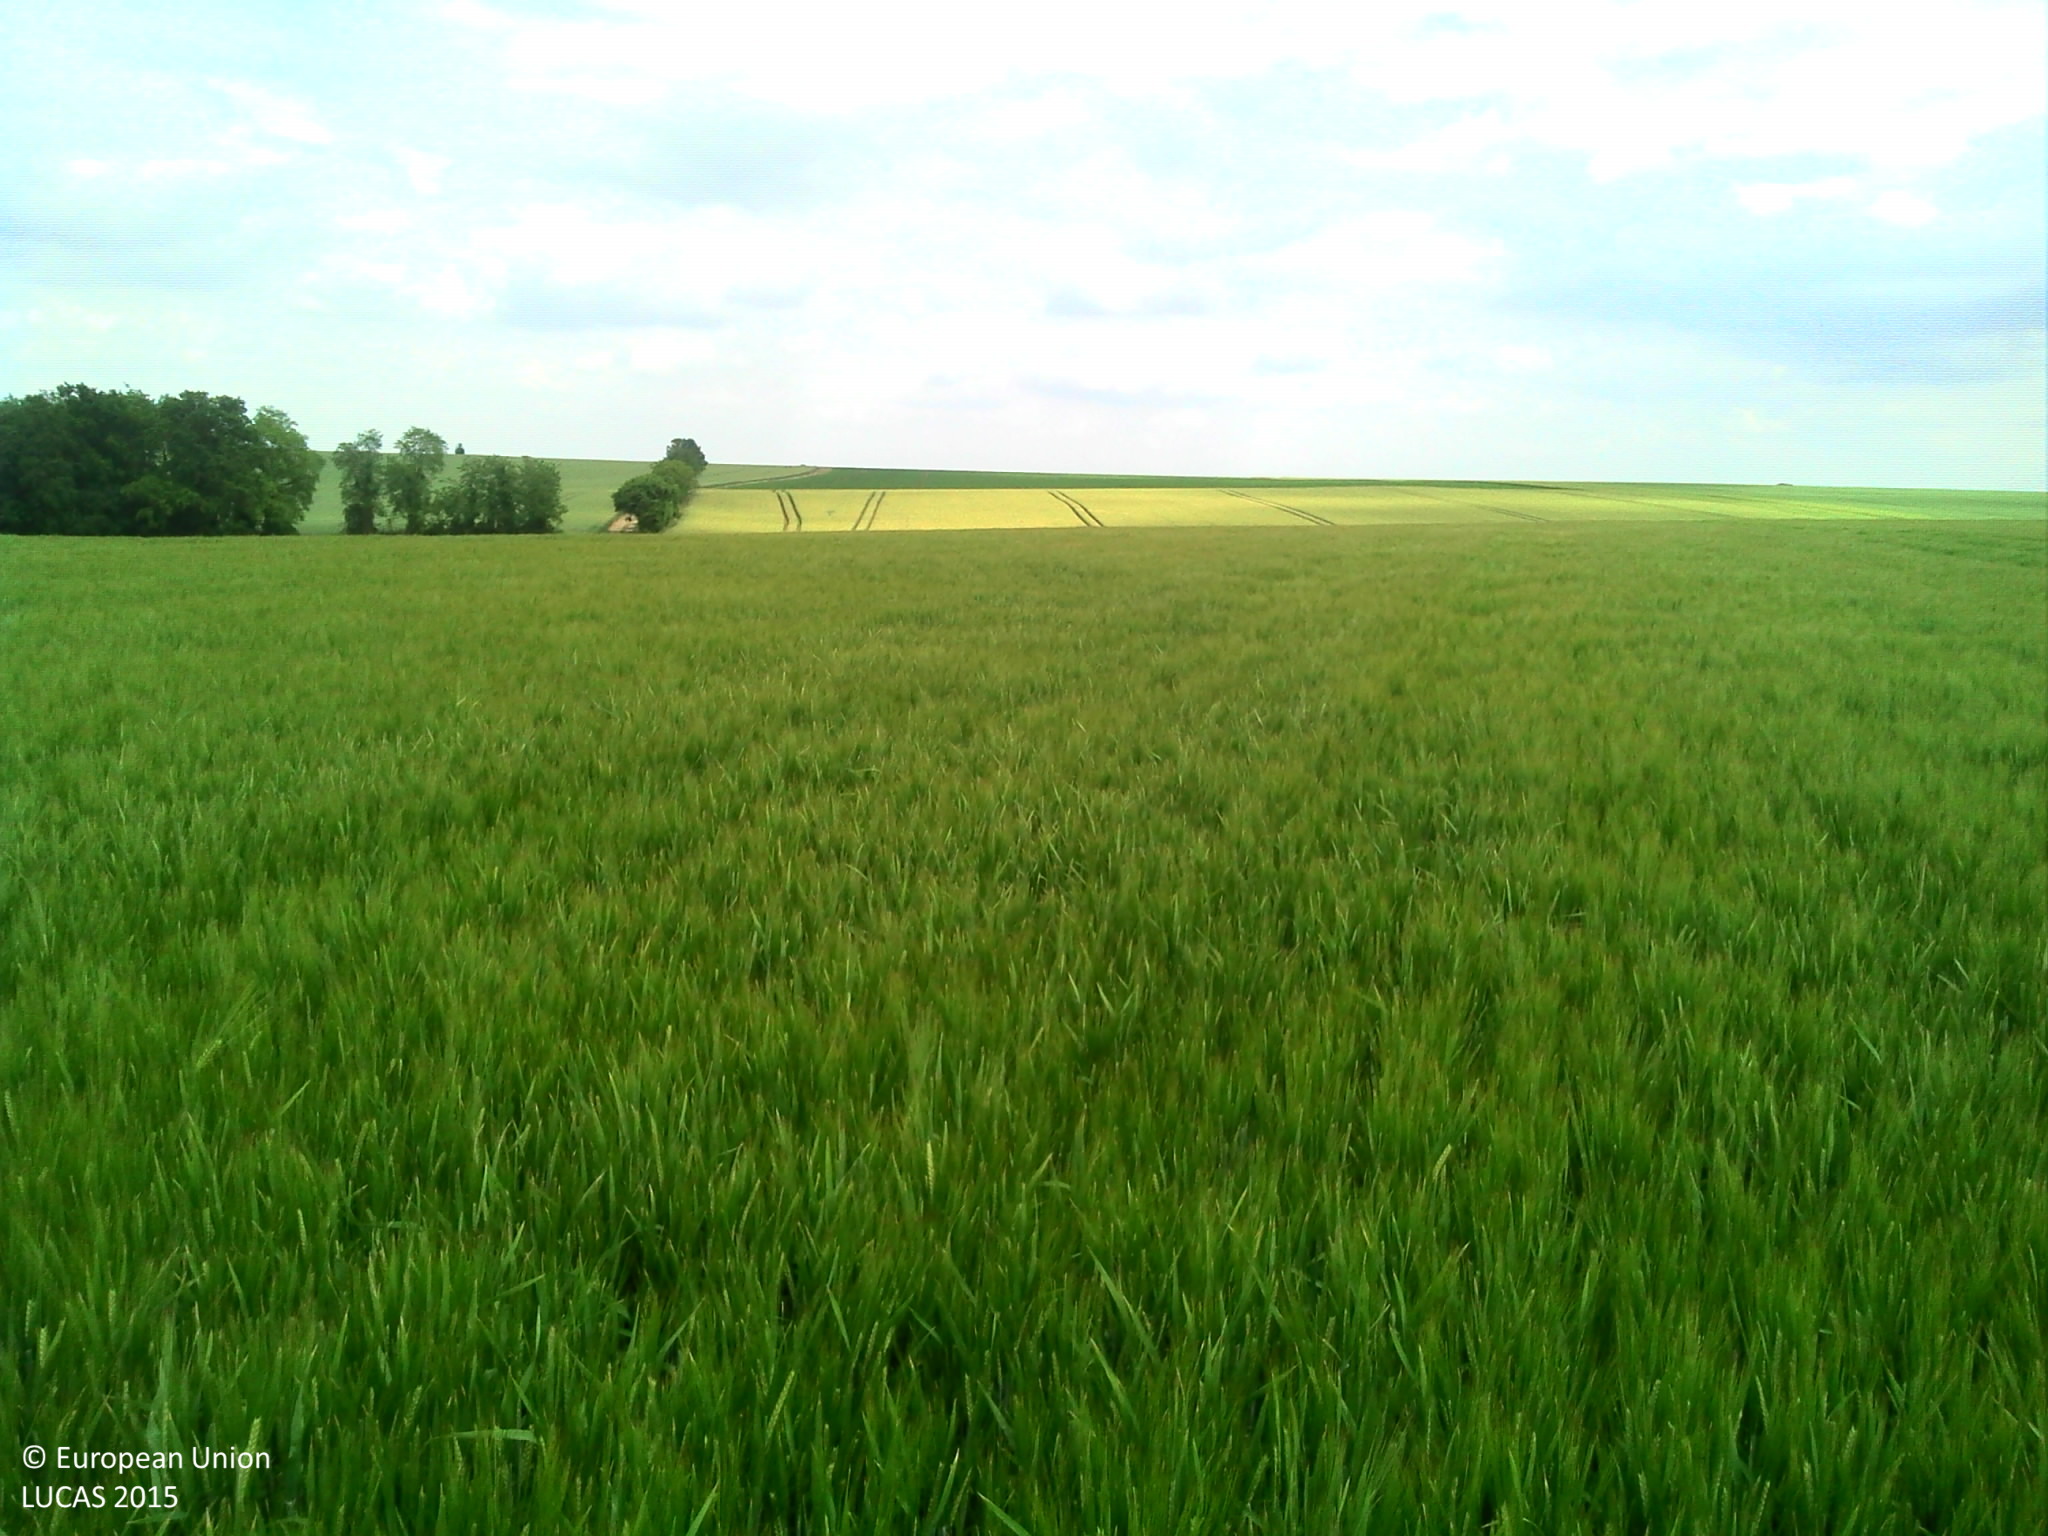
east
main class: Cropland
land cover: Barley
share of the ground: > 75 %
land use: Agriculture (excluding fallow land and kitchen gardens)
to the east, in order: Barley; Grass margins; Tracks; Grass margins; Common wheat
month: June
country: FR
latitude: 49.3428
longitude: 3.7037
